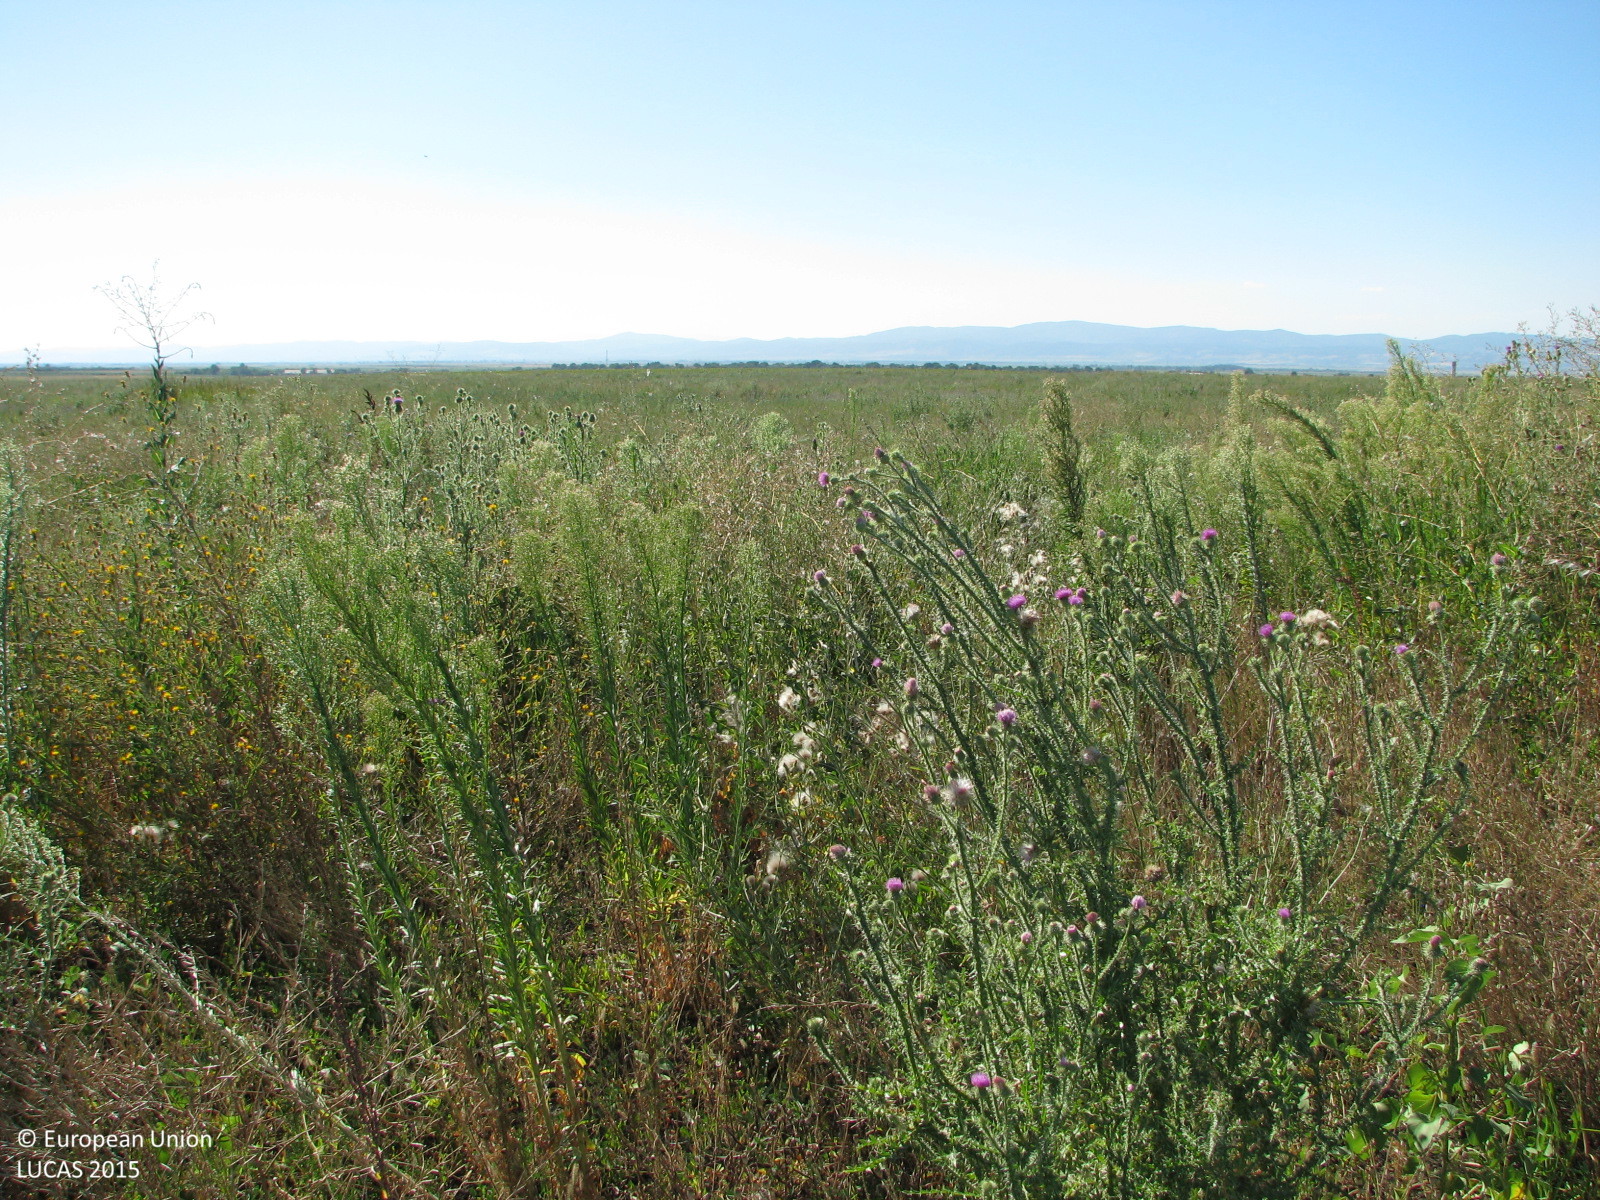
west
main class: Grassland
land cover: Spontaneously vegetated surfaces
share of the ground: > 75 %
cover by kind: herbaceous plants 100 %
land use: Fallow land
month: July
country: BG
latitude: 42.3788
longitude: 26.0264
